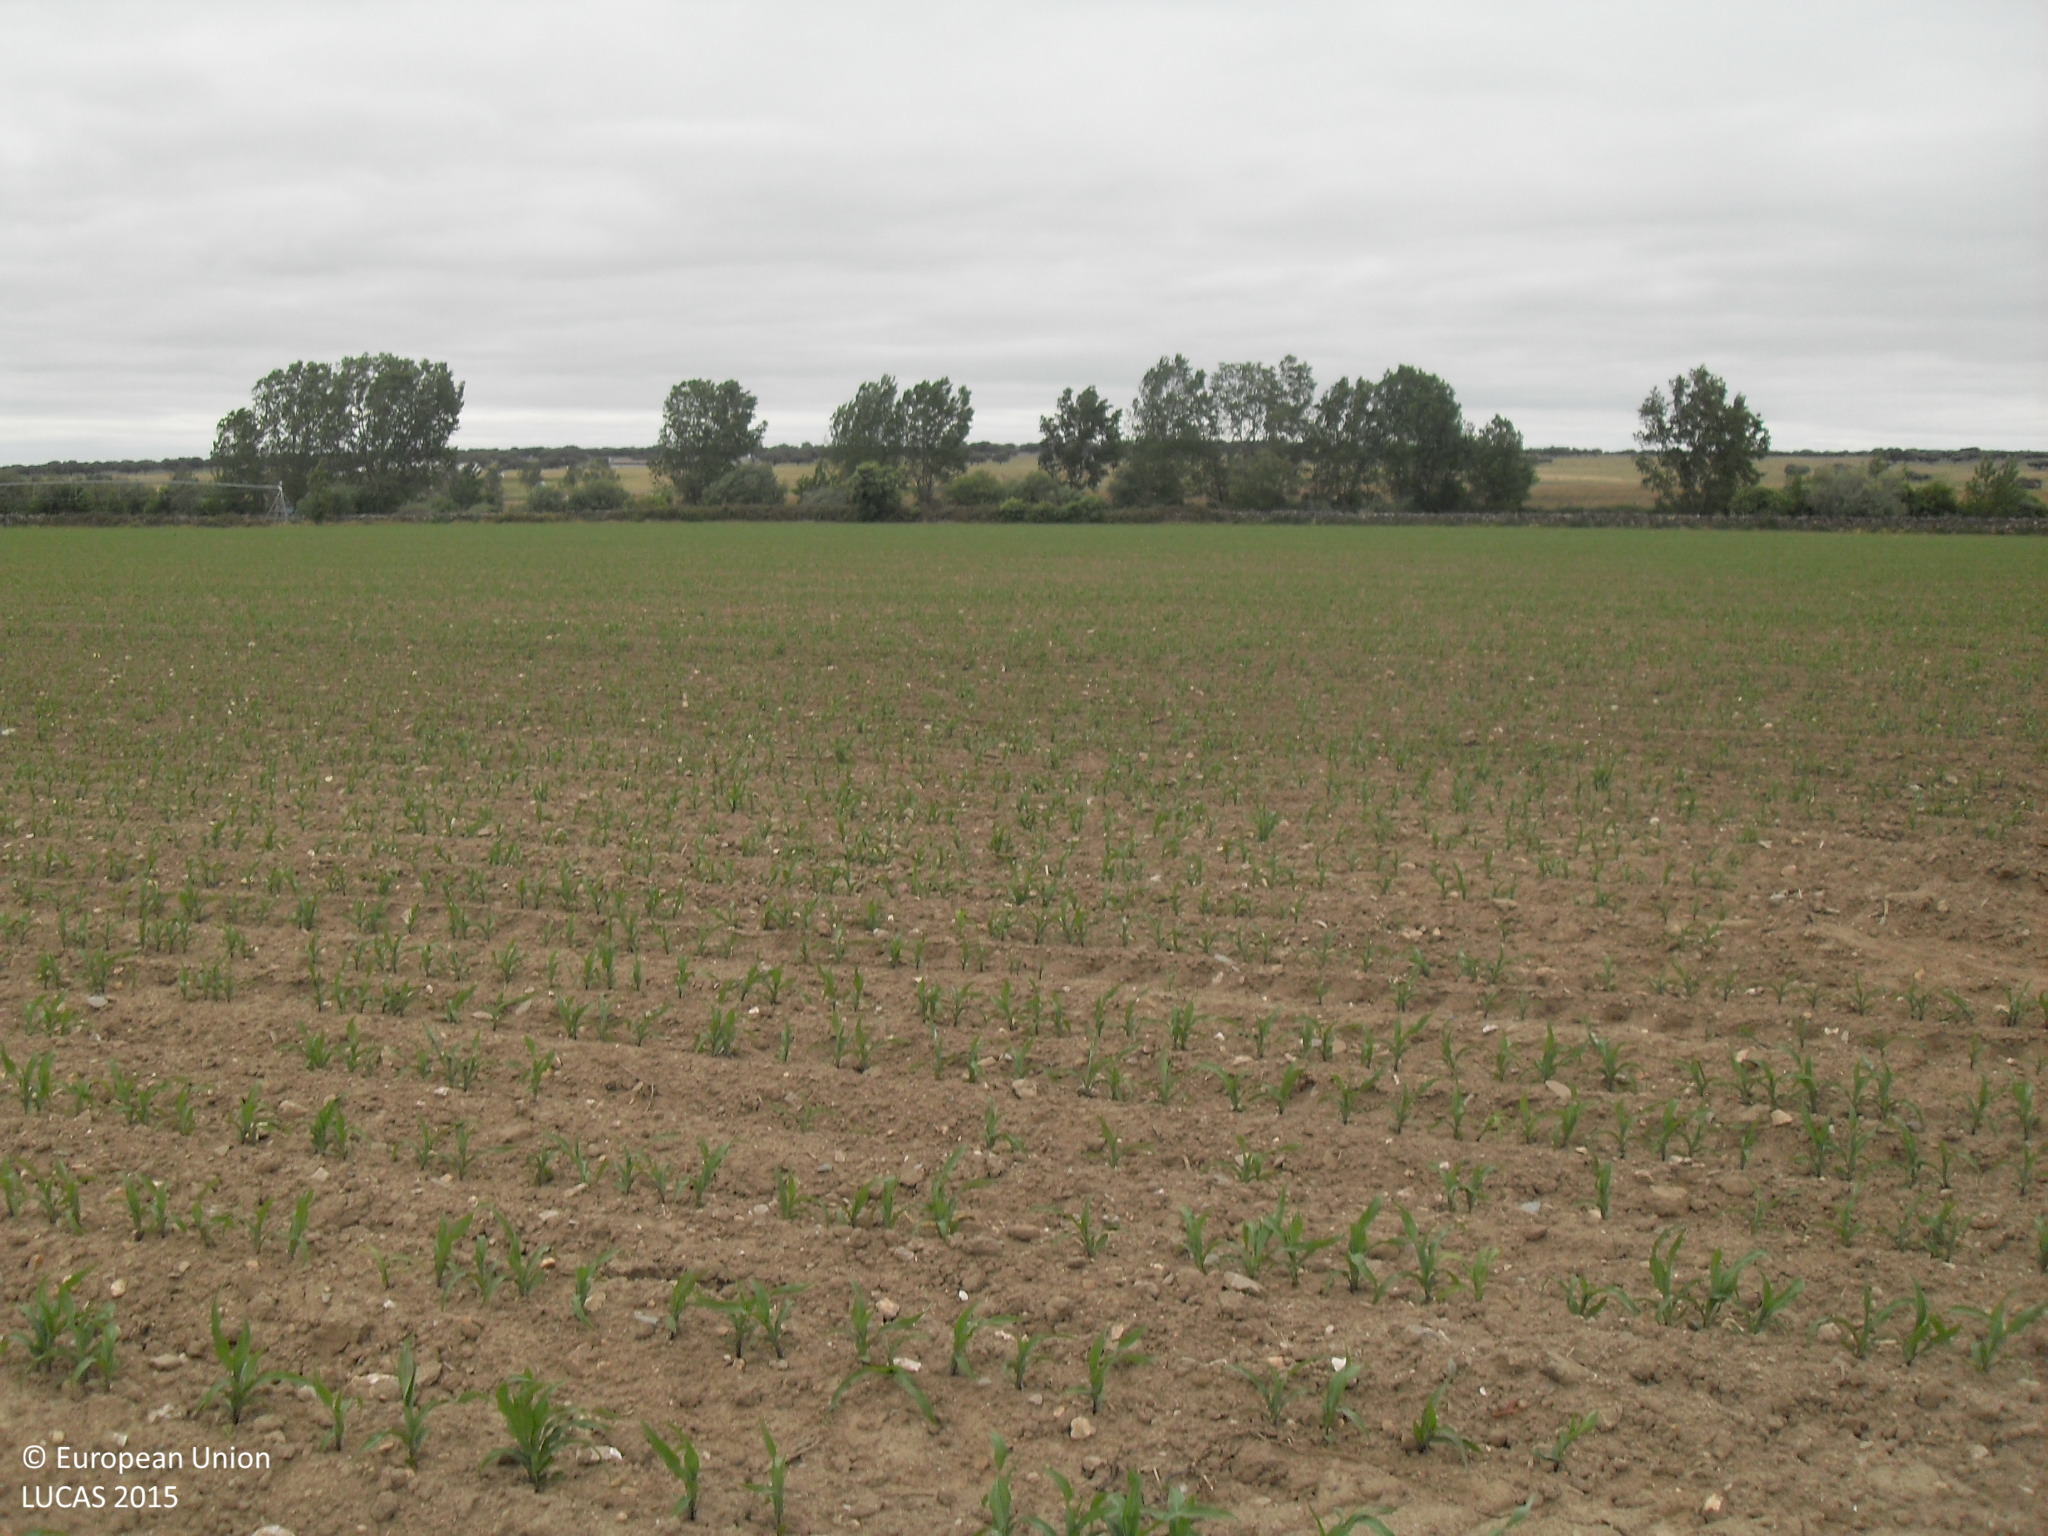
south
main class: Cropland
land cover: Maize
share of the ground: > 75 %
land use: Agriculture (excluding fallow land and kitchen gardens)
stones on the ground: < 10 %
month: May
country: ES
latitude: 40.6889
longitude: -5.6813
